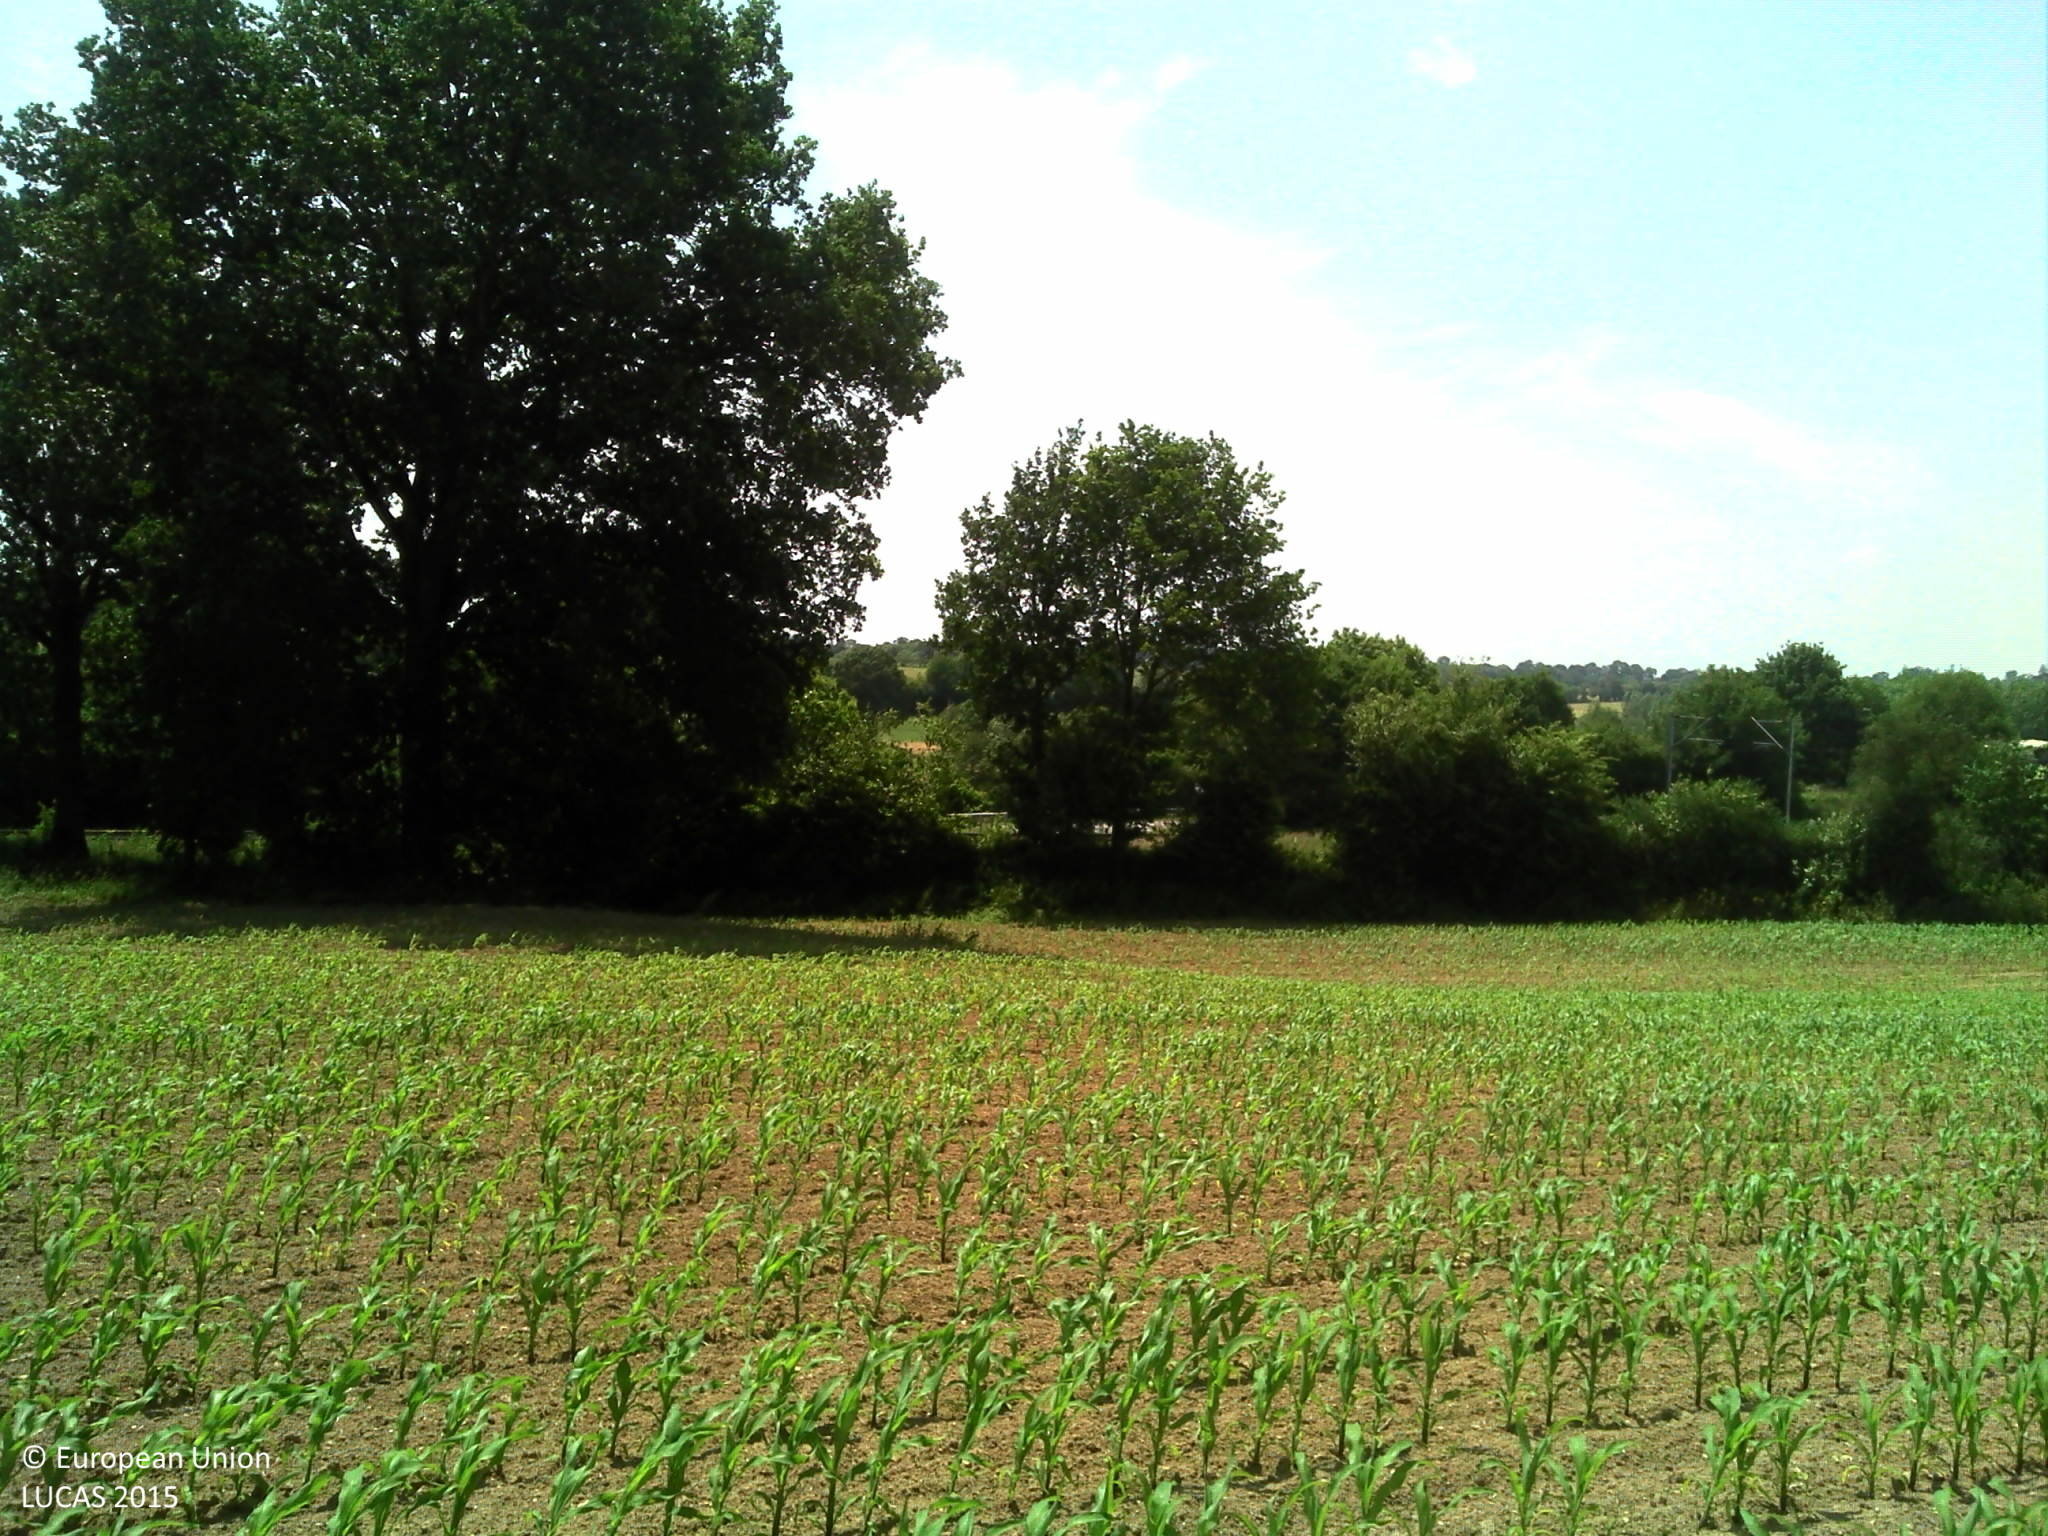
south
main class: Cropland
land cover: Maize
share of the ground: < 10 %
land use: Agriculture (excluding fallow land and kitchen gardens)
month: June
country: FR
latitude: 48.1129
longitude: -1.1221
